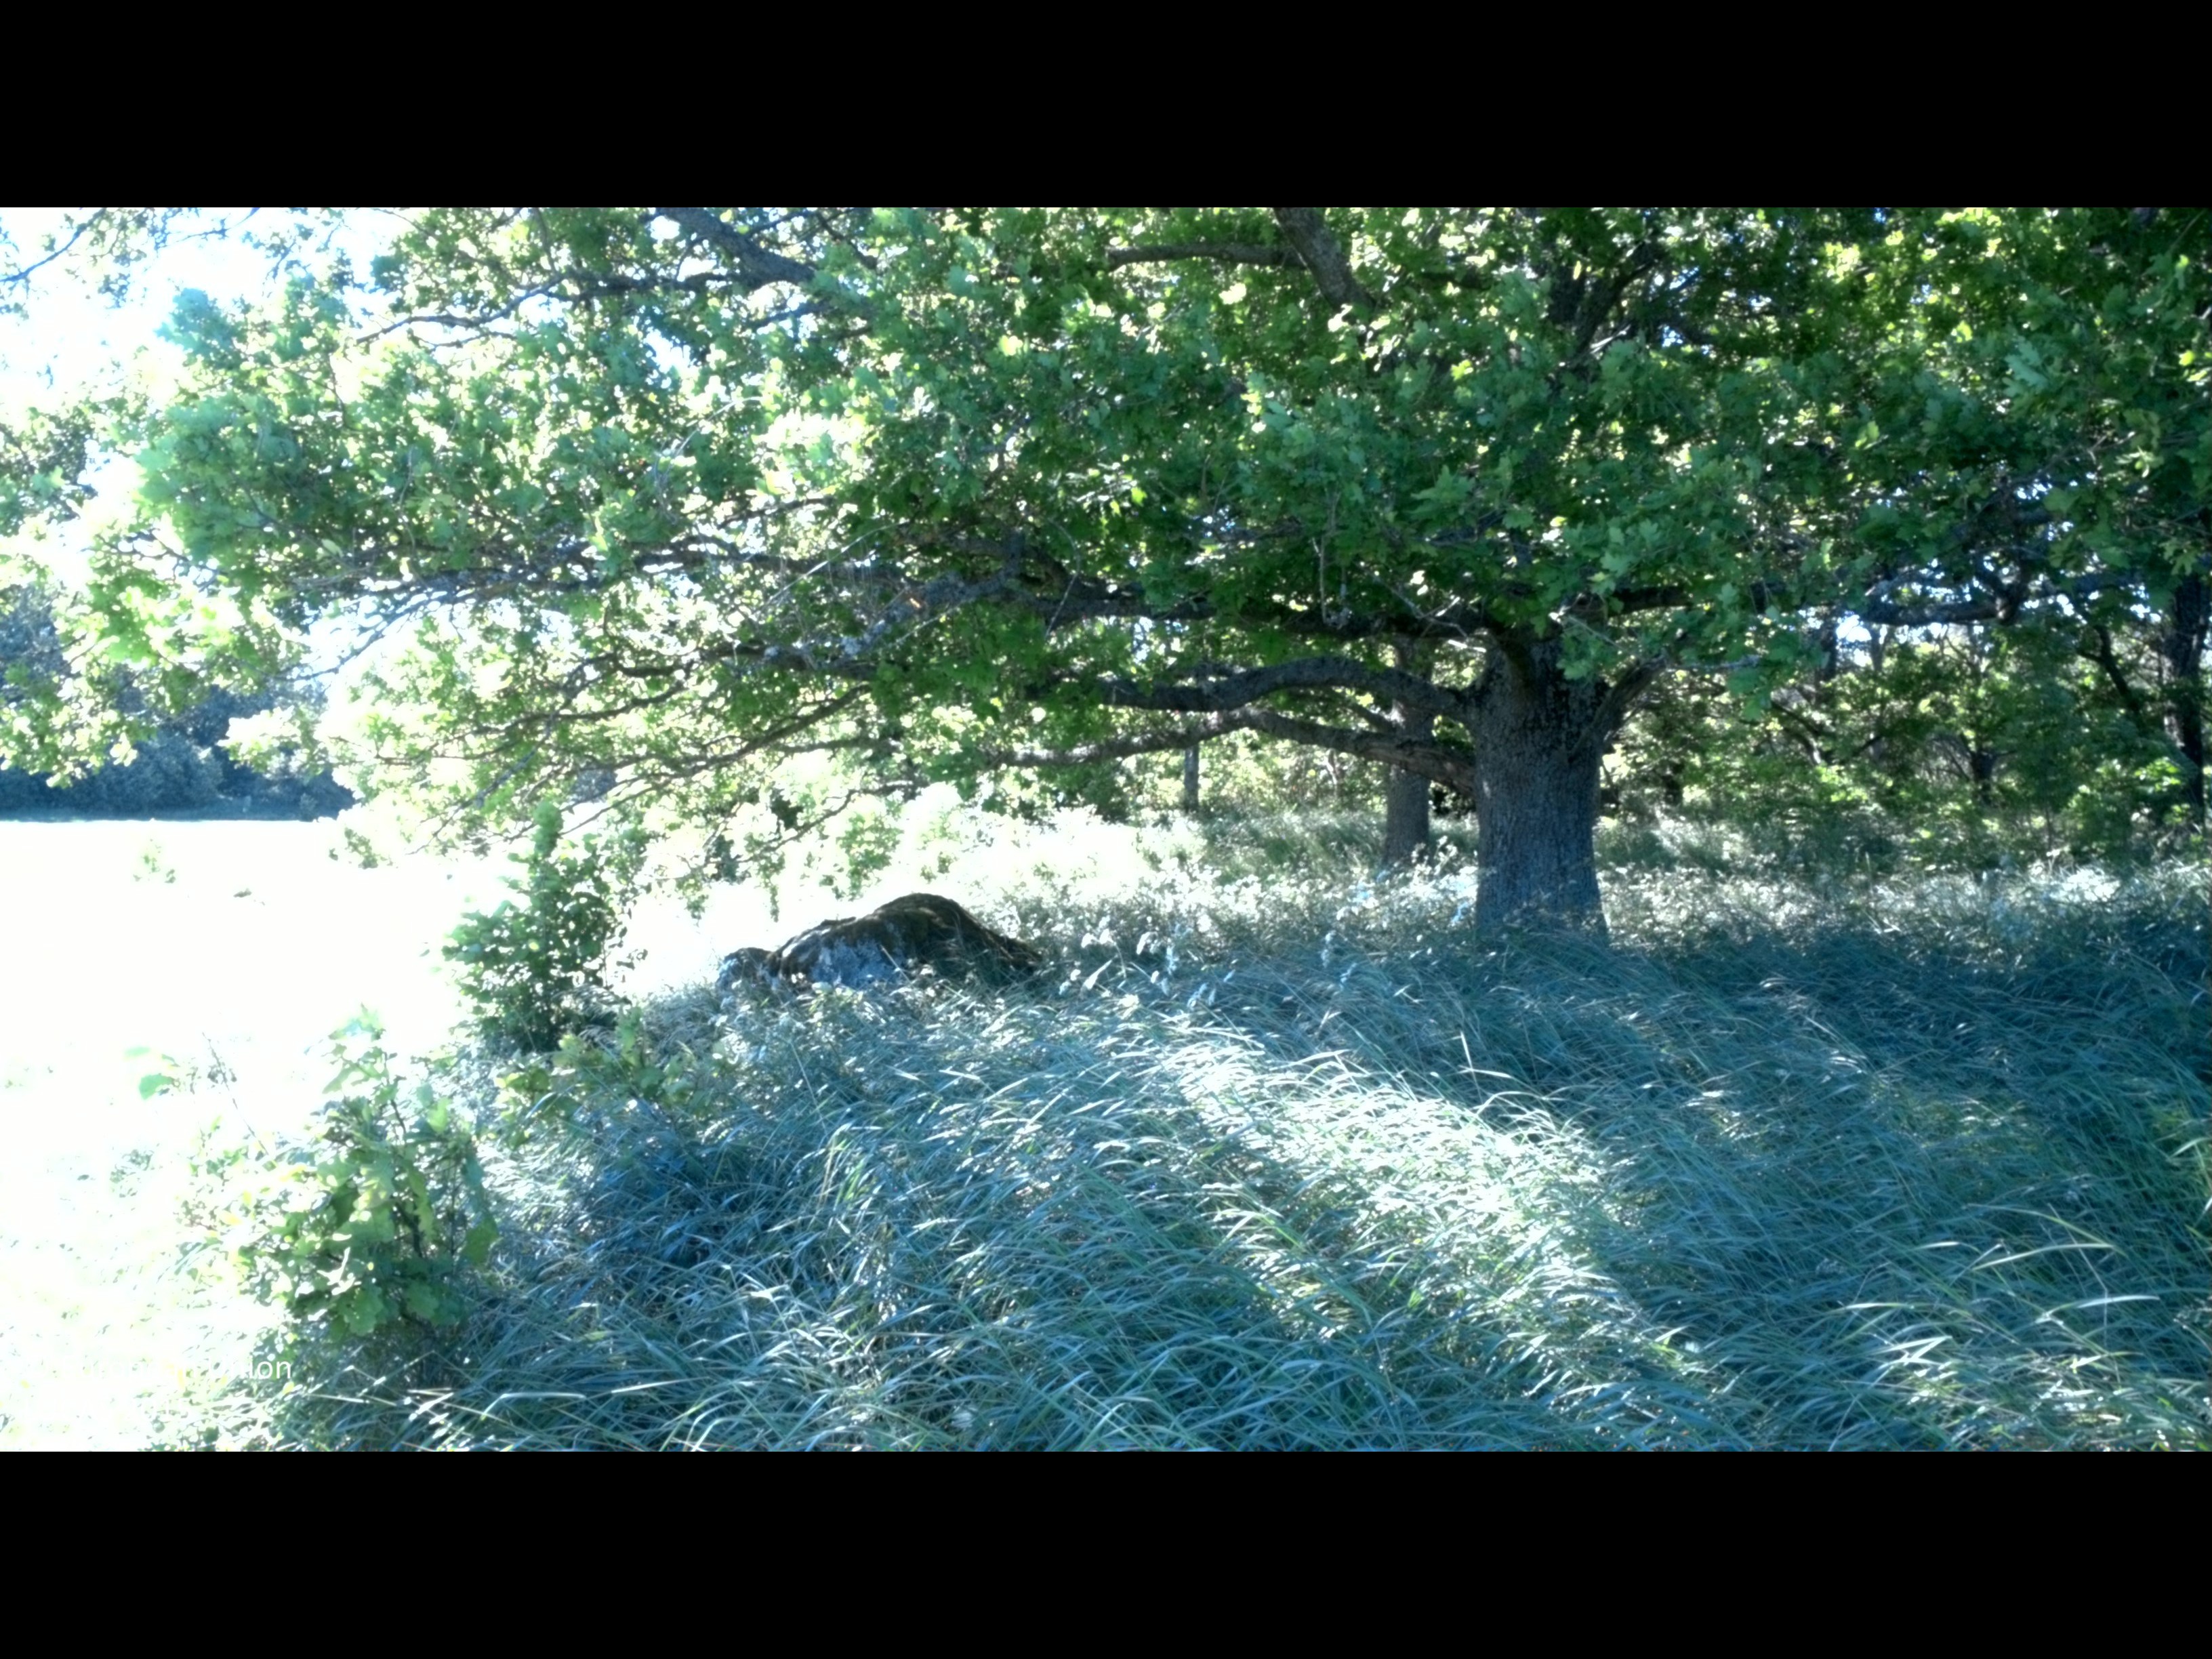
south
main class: Woodland
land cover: Broadleaved woodland
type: hemiboreal forest and nemoral coniferous forest and mixed broadleaved-coniferous forest
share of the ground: 50 - 75 %
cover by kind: broadleaved forest trees 75 %, herbaceous plants 20 %, shrubs 5 %
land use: Forestry
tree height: > 5 m
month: June
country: SE
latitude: 57.7308
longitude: 16.6323
